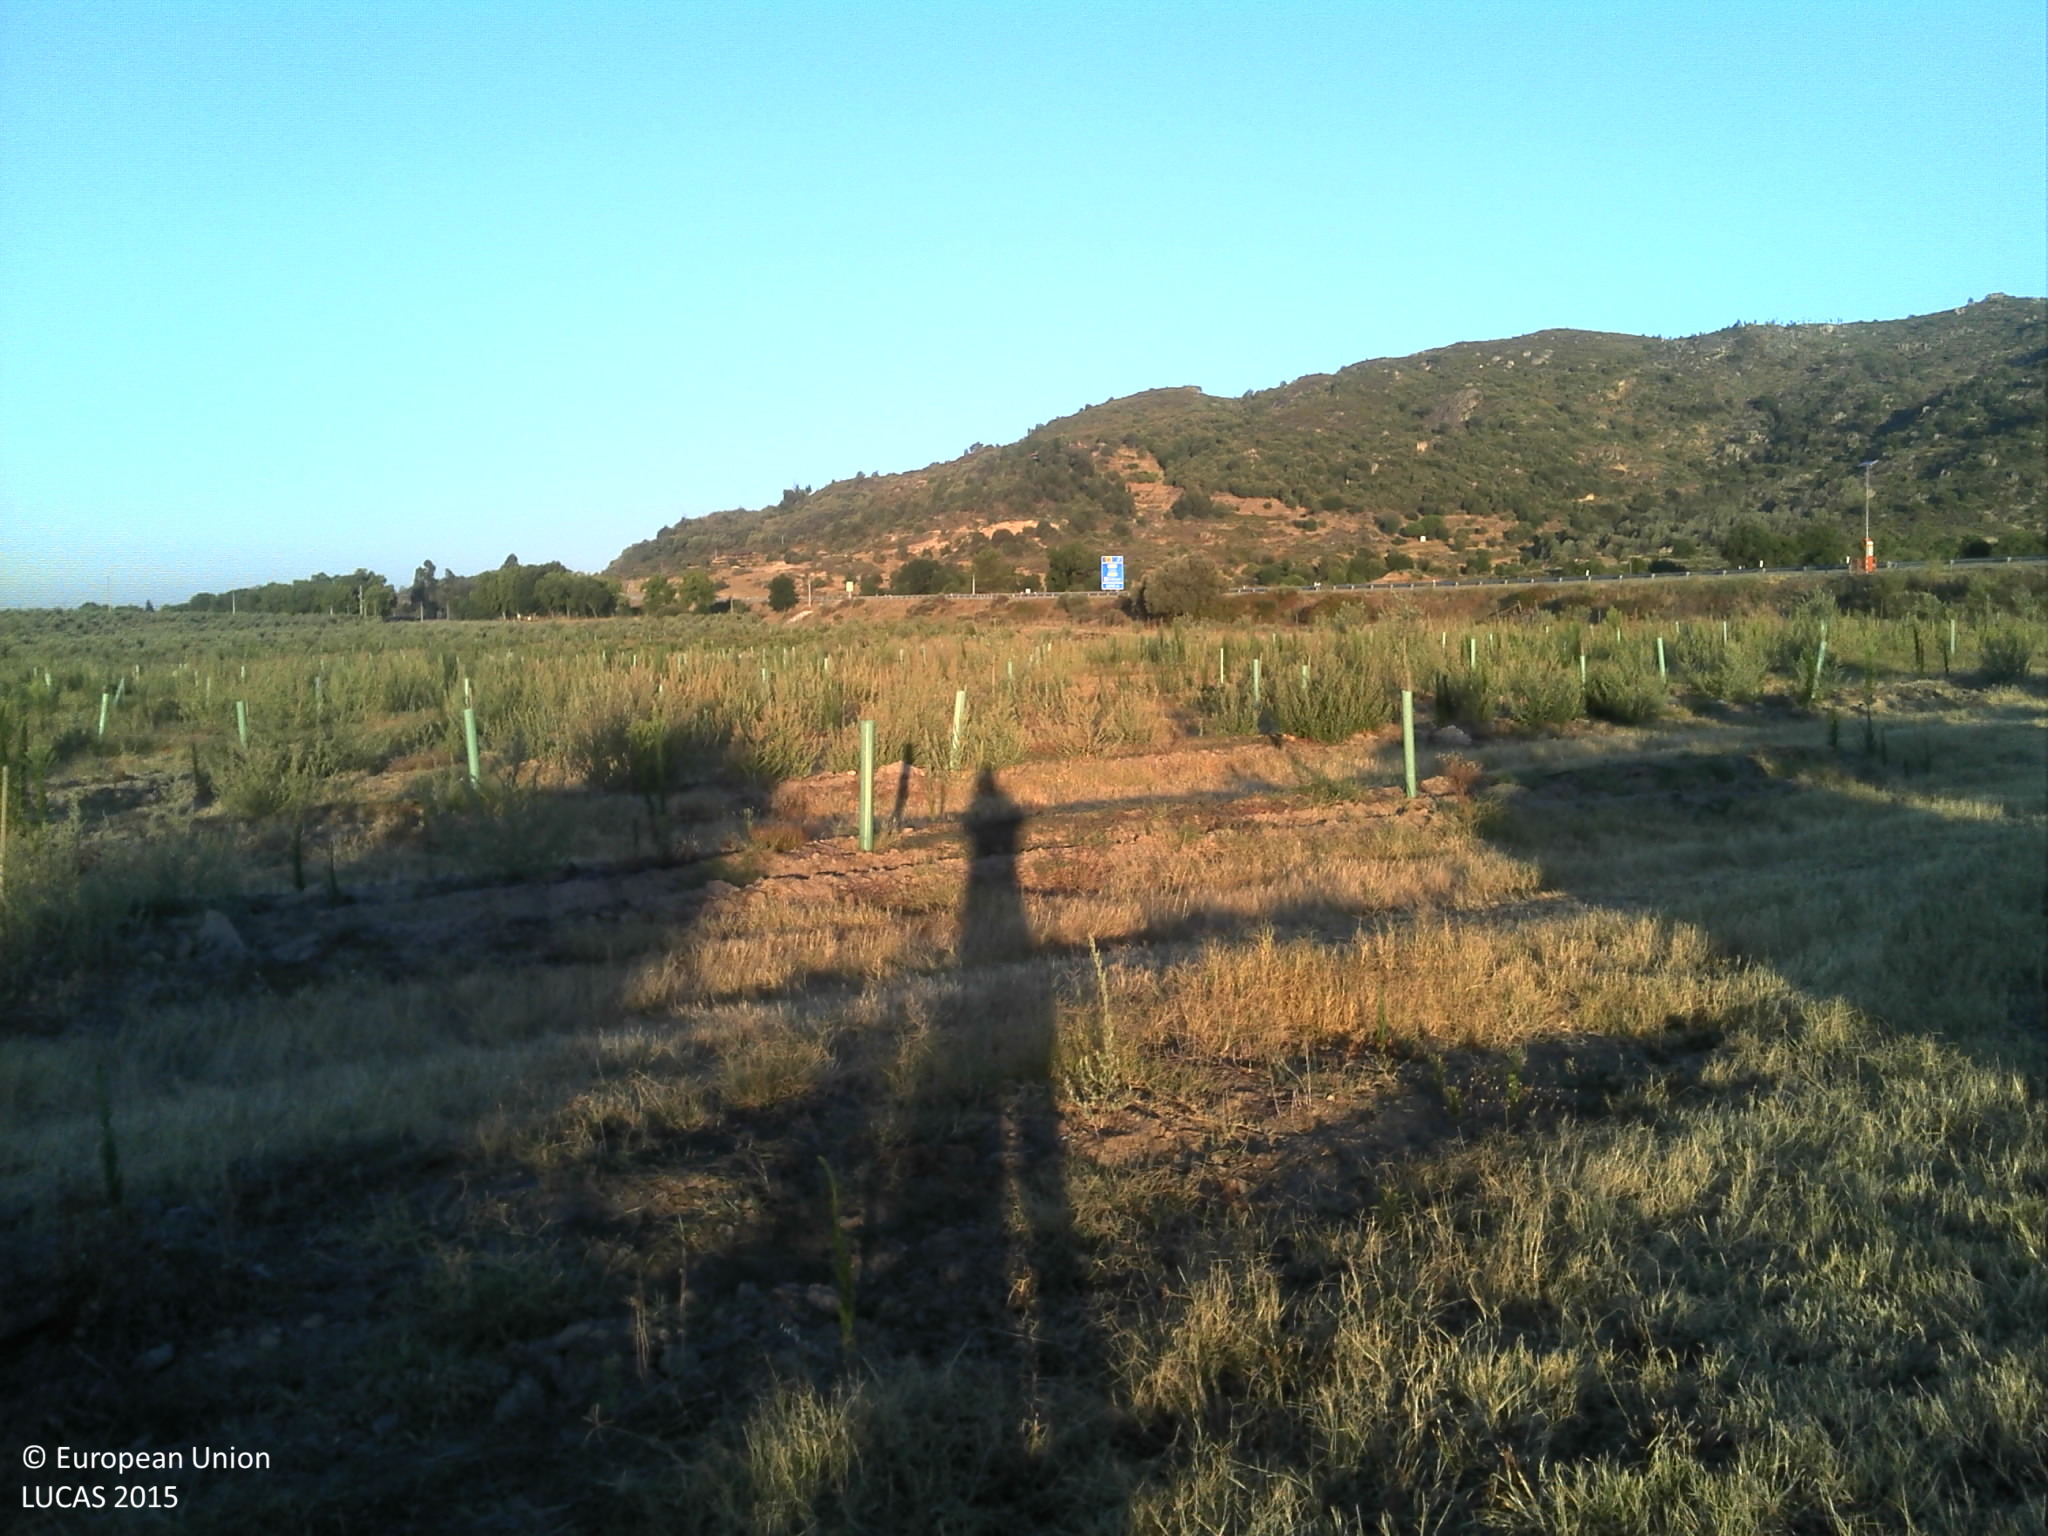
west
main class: Grassland
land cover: Grassland without tree/shrub cover
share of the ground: 50 - 75 %
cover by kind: herbaceous plants 55 %, unconsolidated bare surface 45 %
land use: Agriculture (excluding fallow land and kitchen gardens)
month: July
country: PT
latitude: 40.3322
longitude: -7.3481
